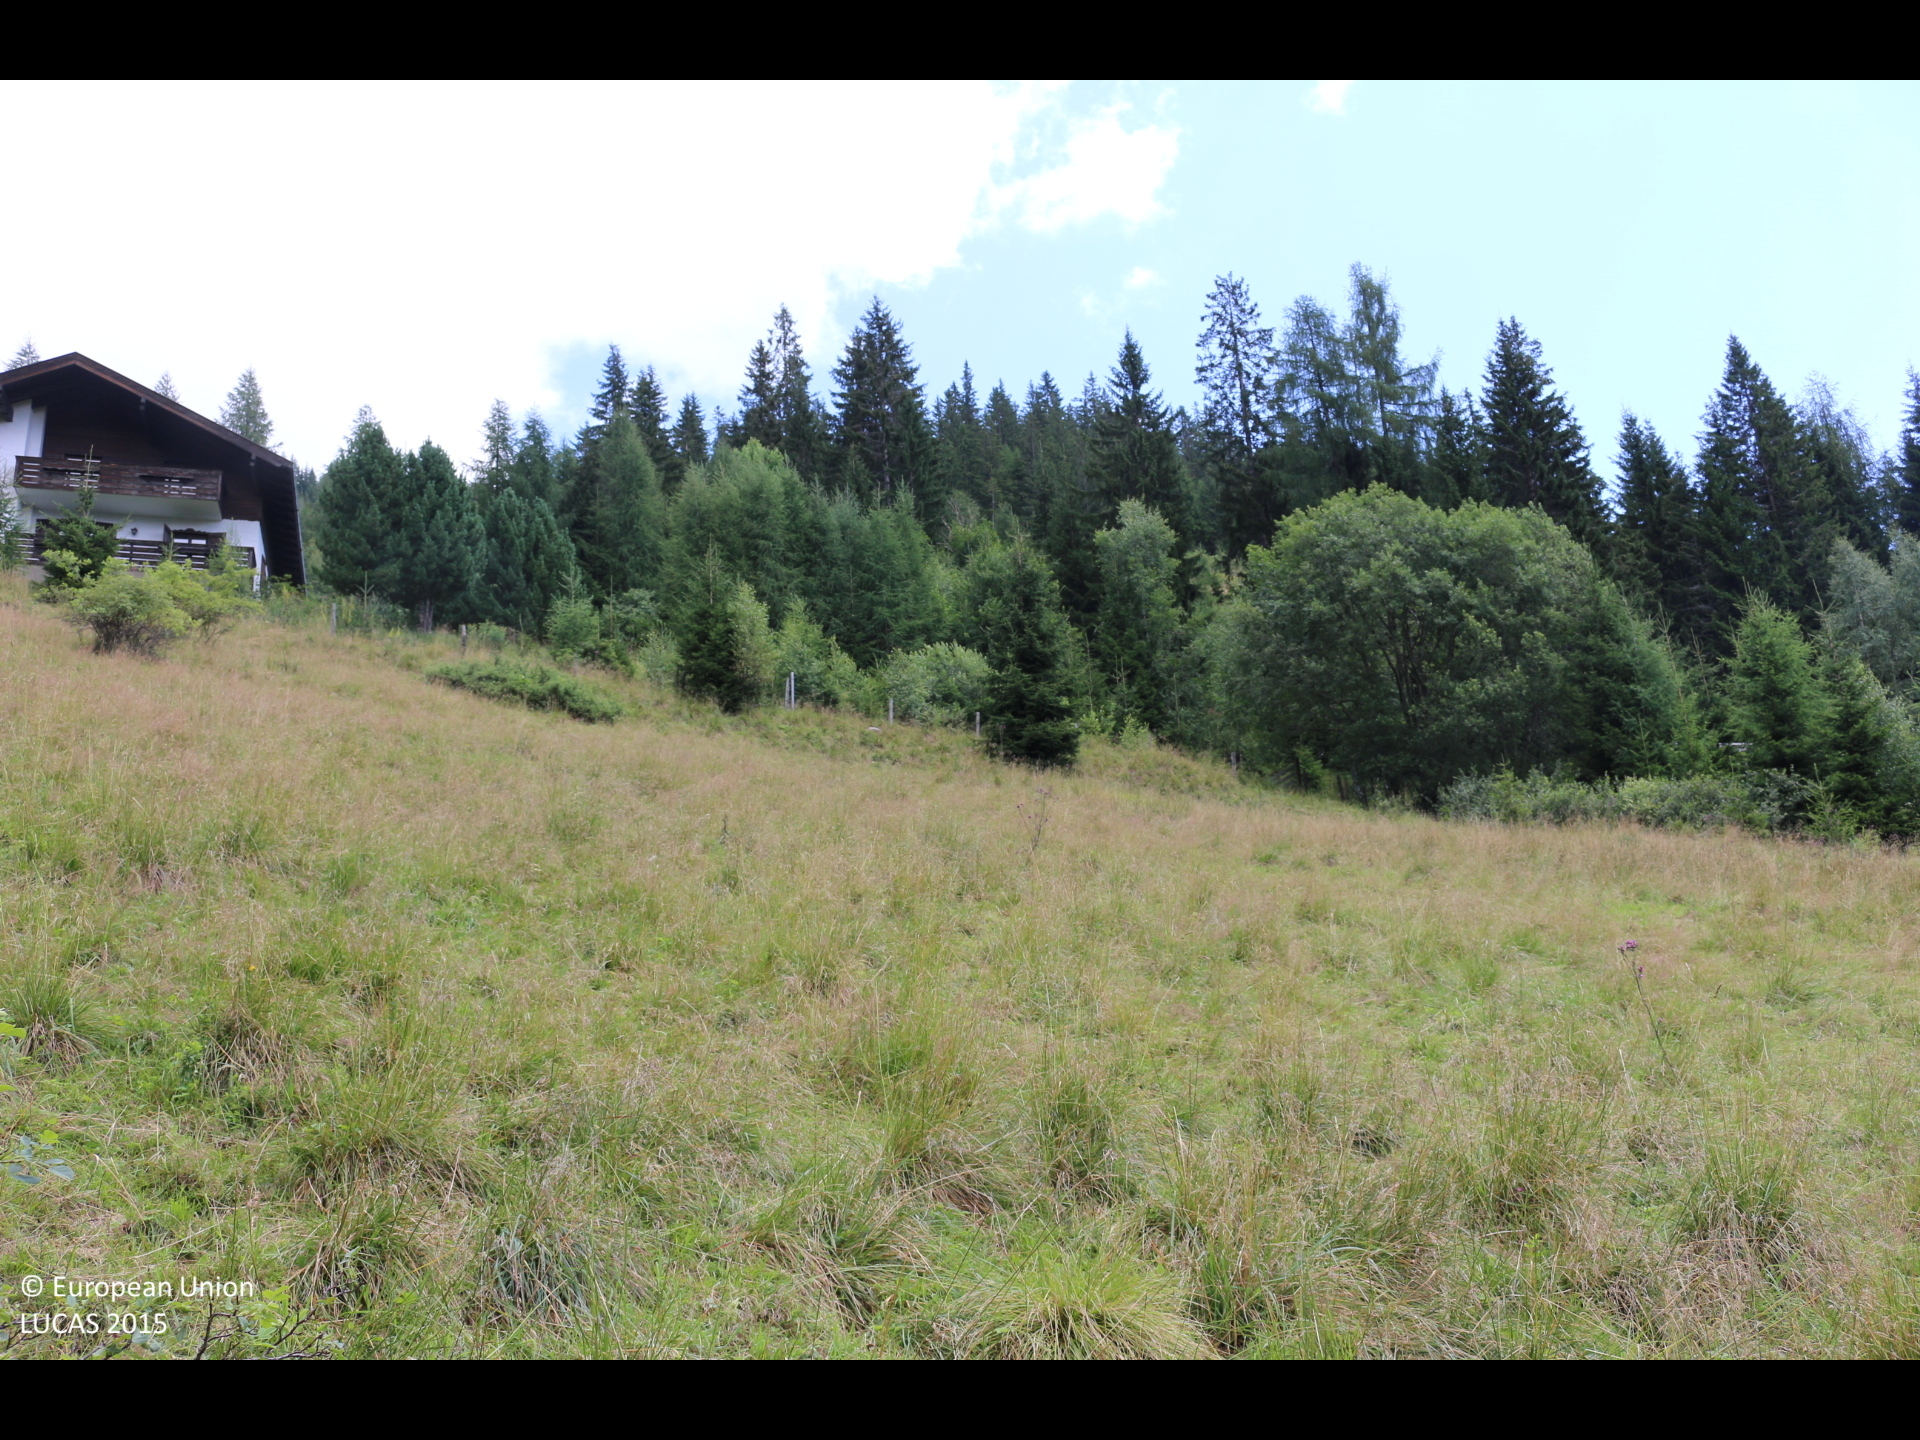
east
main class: Grassland
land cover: Grassland without tree/shrub cover
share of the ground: > 75 %
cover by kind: herbaceous plants 100 %
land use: Agriculture (excluding fallow land and kitchen gardens)
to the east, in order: Grassland without tree/shrub cover; Grassland with sparse tree/shrub cover; Fences; Tracks; Spruce dominated mixed woodland; Grassland without tree/shrub cover; Spruce dominated mixed woodland; Fences; Grassland without tree/shrub cover; Fences; Spruce dominated coniferous woodland; Tracks; Spruce dominated coniferous woodland; Tracks; Spruce dominated coniferous woodland
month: July
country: AT
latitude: 46.7475
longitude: 13.9375
